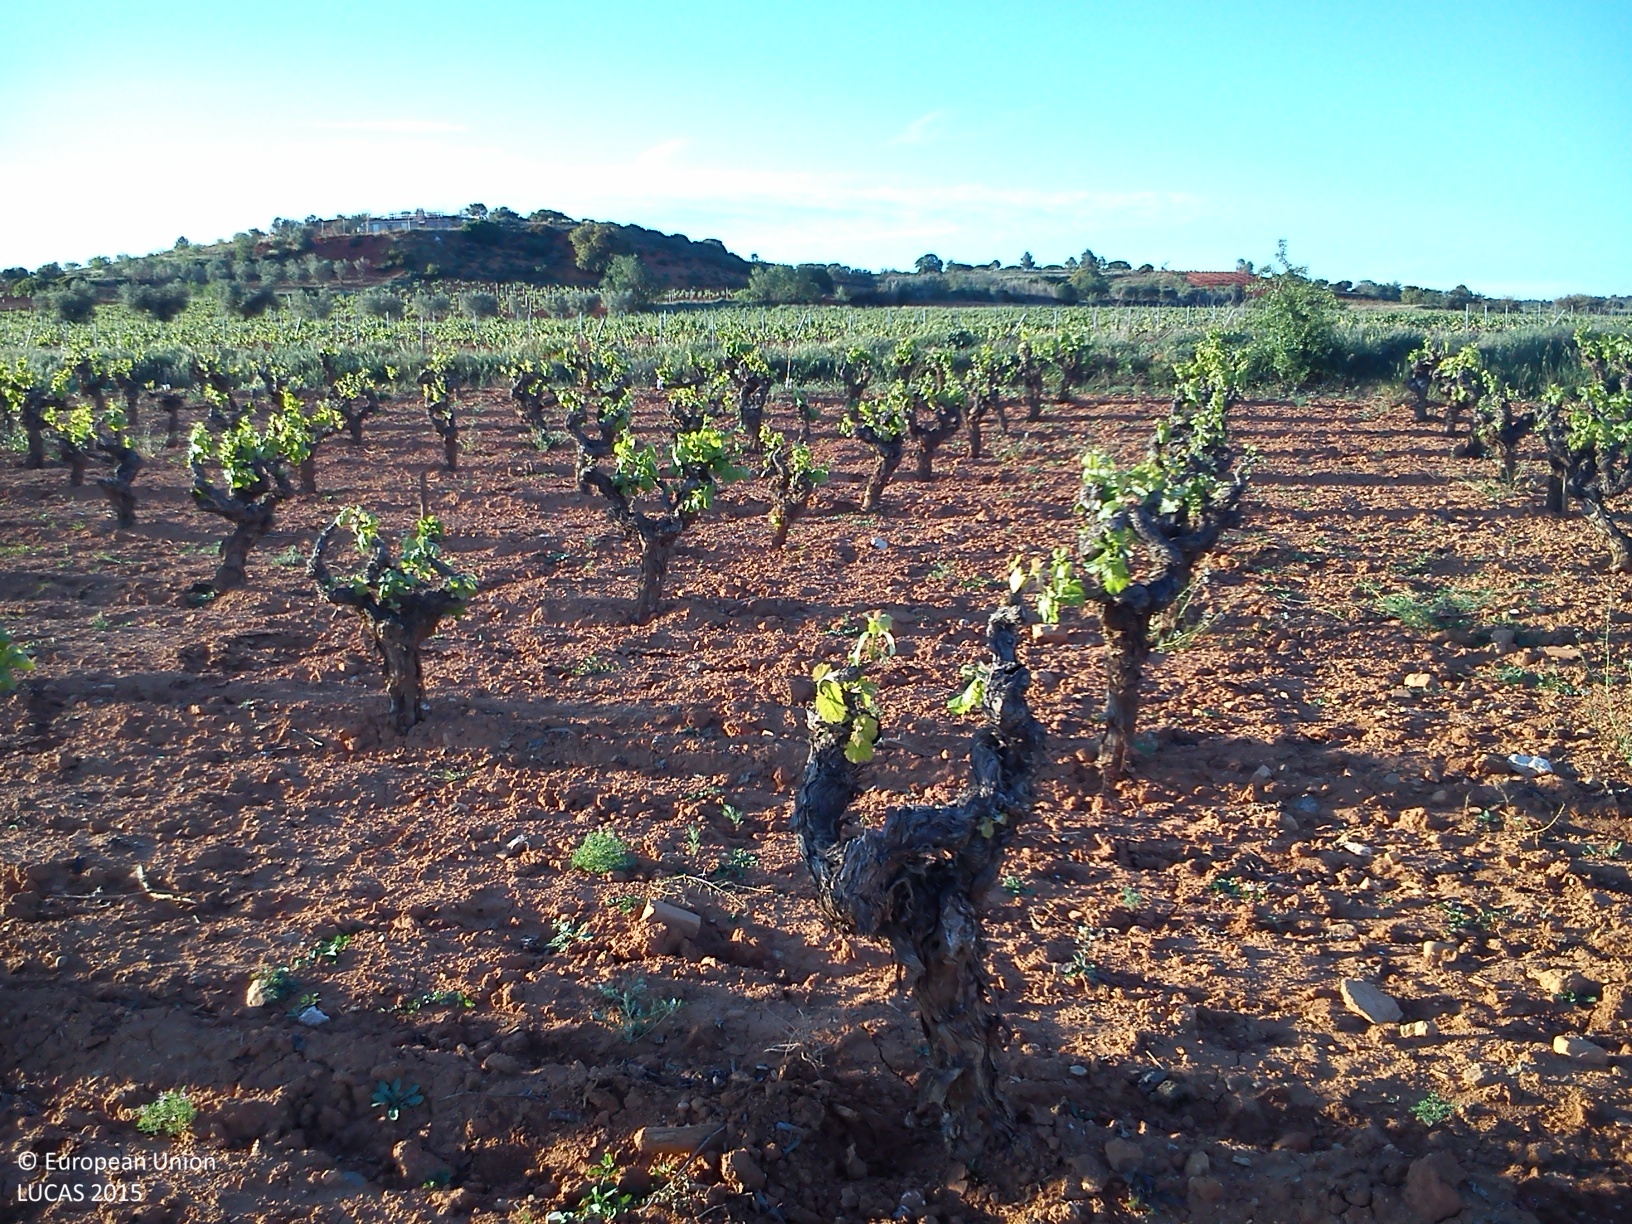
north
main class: Cropland
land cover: Vineyards
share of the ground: 10 - 25 %
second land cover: Other bare soil
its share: > 75 %
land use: Agriculture (excluding fallow land and kitchen gardens)
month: May
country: ES
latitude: 39.5094
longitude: -1.0853
